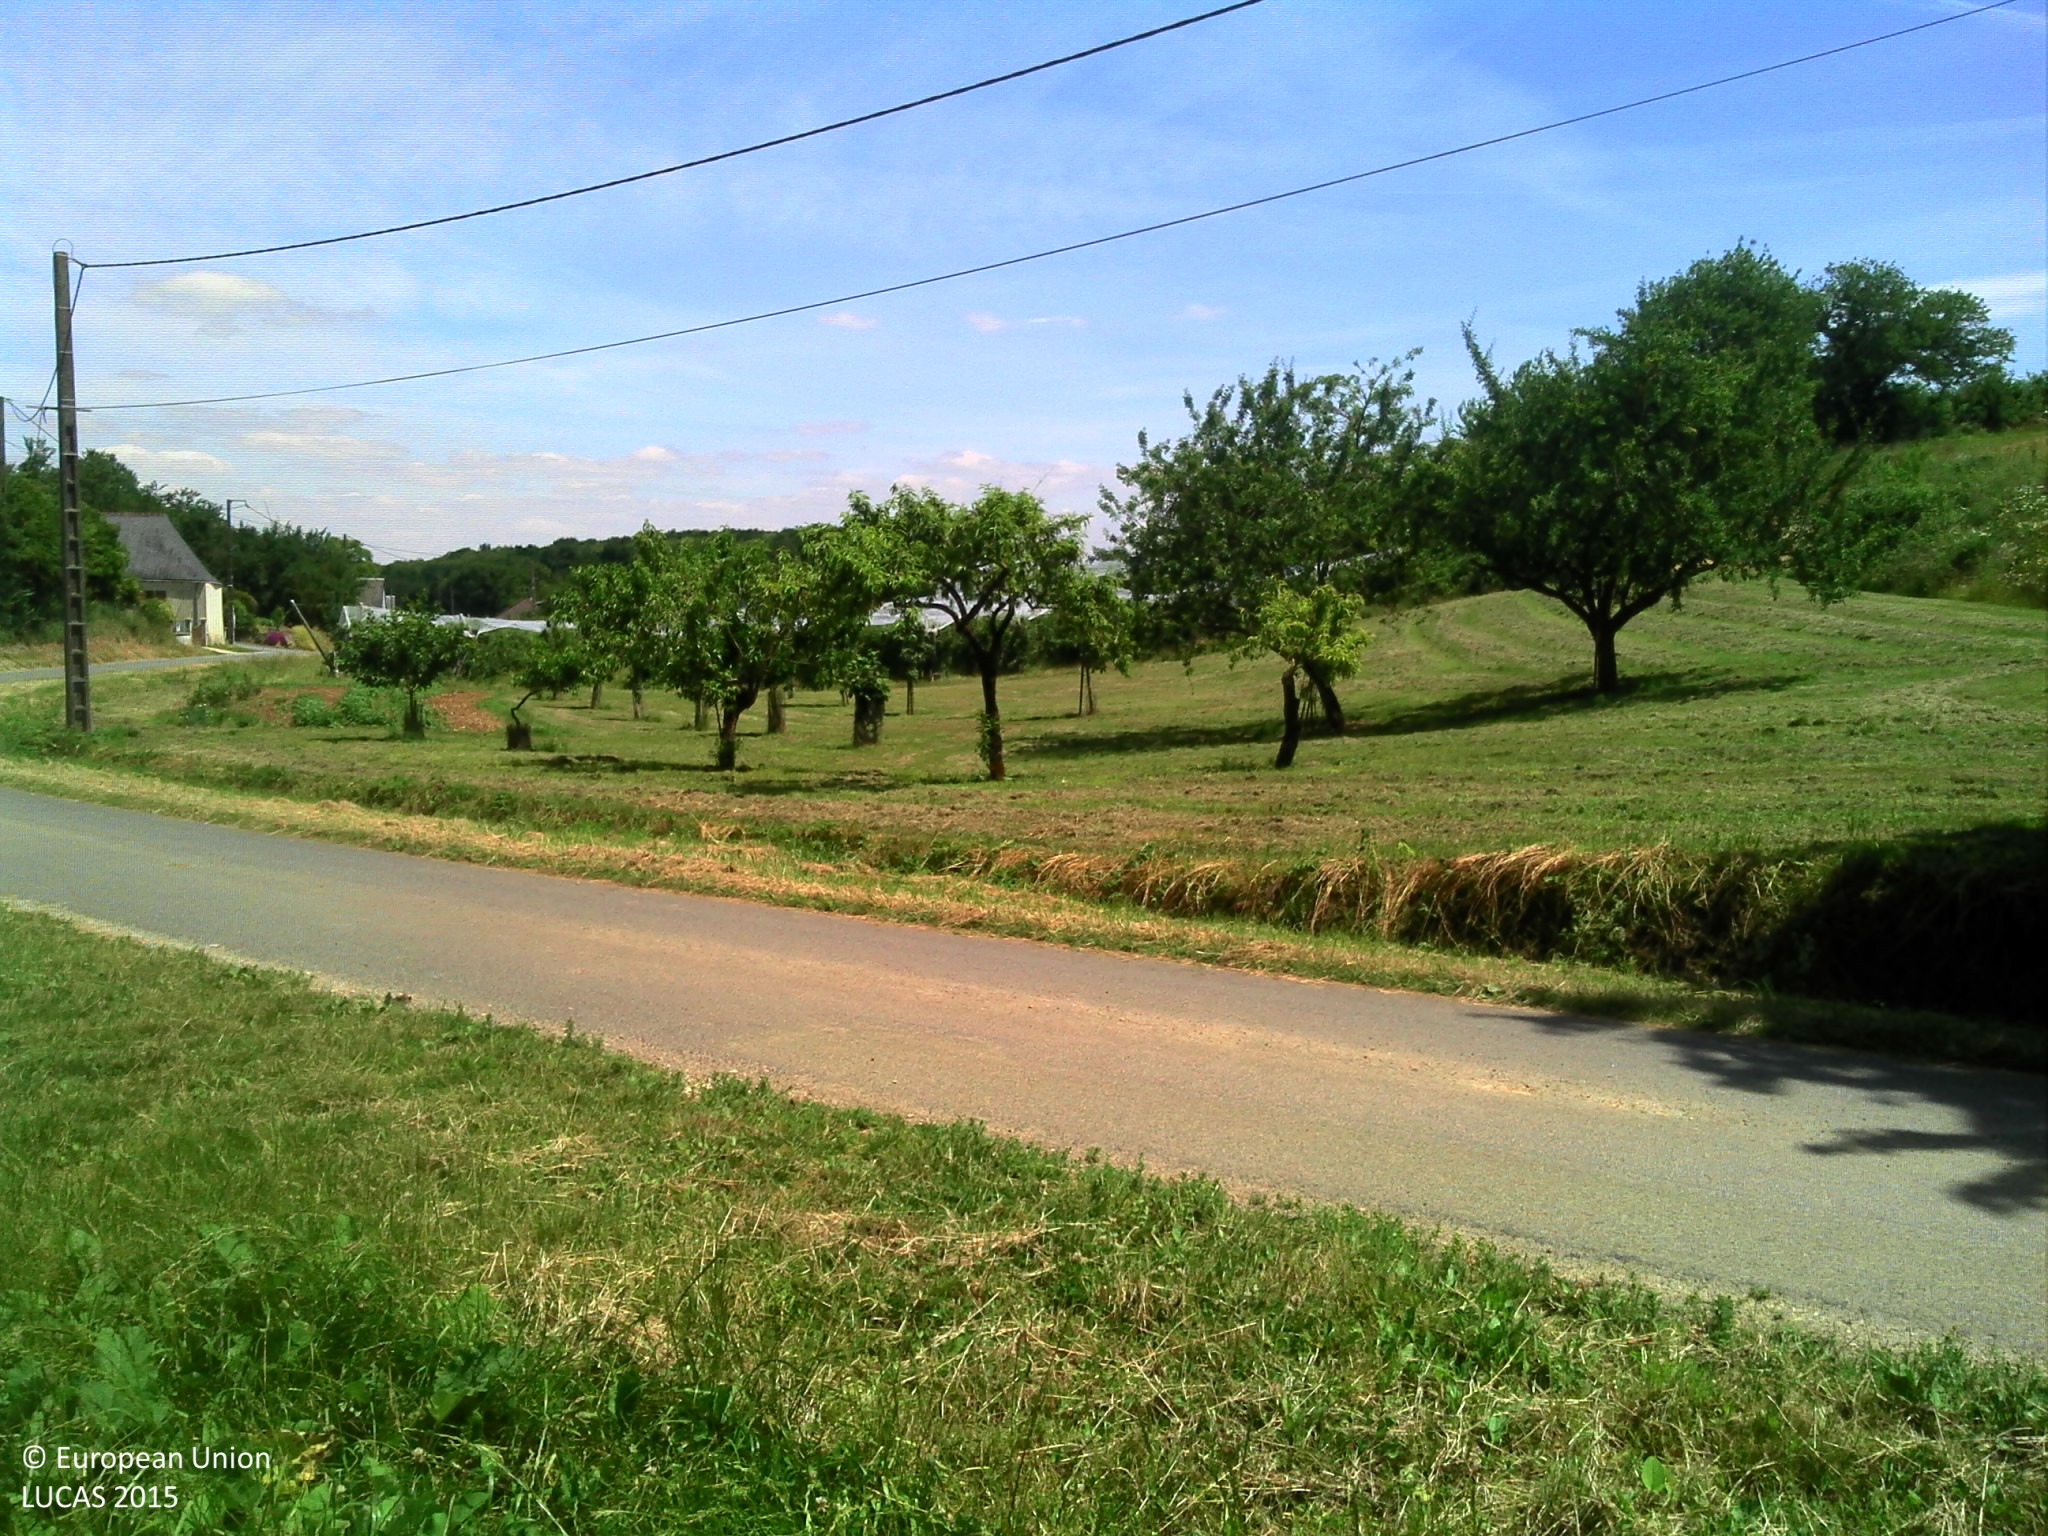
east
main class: Grassland
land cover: Spontaneously vegetated surfaces
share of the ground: 50 - 75 %
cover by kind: herbaceous plants 75 %, consolidated bare surface 25 %
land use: Construction
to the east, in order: Spontaneously vegetated surfaces; Grass margins; Paved roads, cycling and walking lanes; Grass margins; Ditches and canals; Electric lines; Apple fruit; Artificial constructions in urban areas
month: June
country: FR
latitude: 47.6280
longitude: 0.4629
